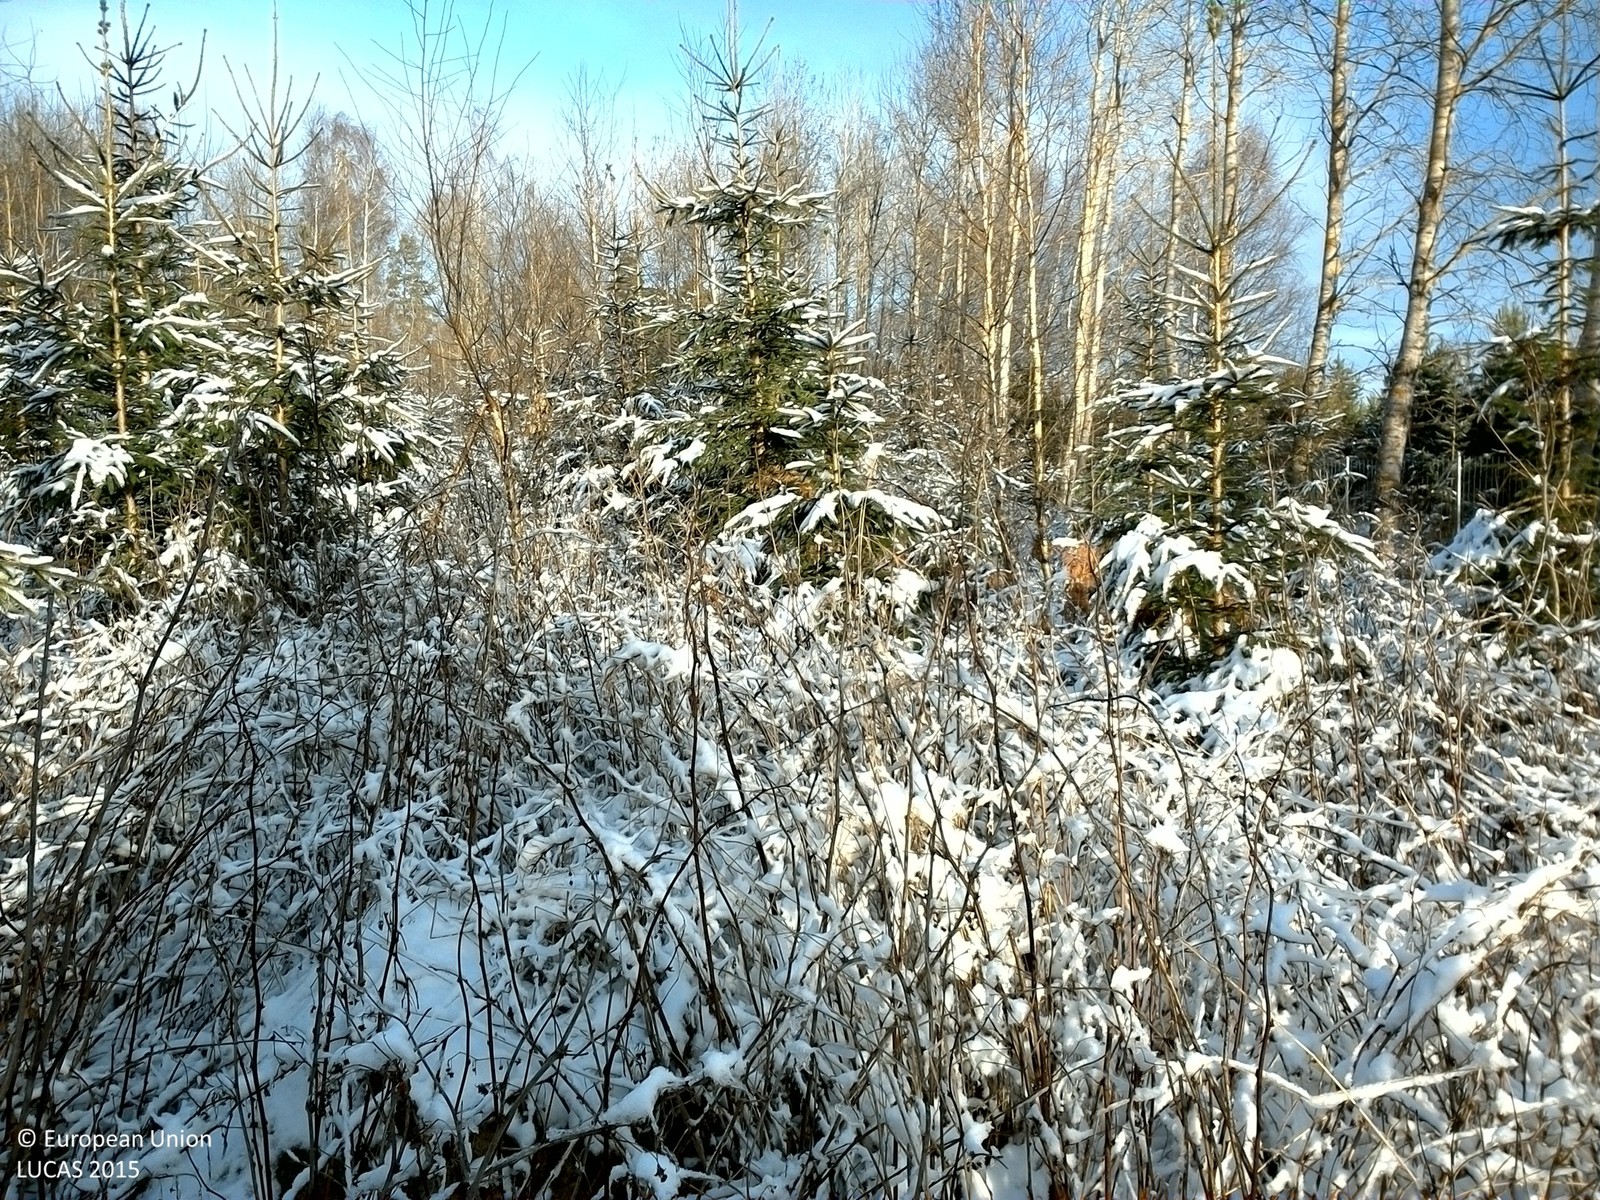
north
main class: Woodland
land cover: Spruce dominated mixed woodland
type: boreal forest
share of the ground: 50 - 75 %
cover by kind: broadleaved forest trees 40 %, shrubs 30 %, coniferous forest trees 20 %, herbaceous plants 10 %
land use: Forestry
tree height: > 5 m
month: December
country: SE
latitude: 59.6854
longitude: 16.5460
